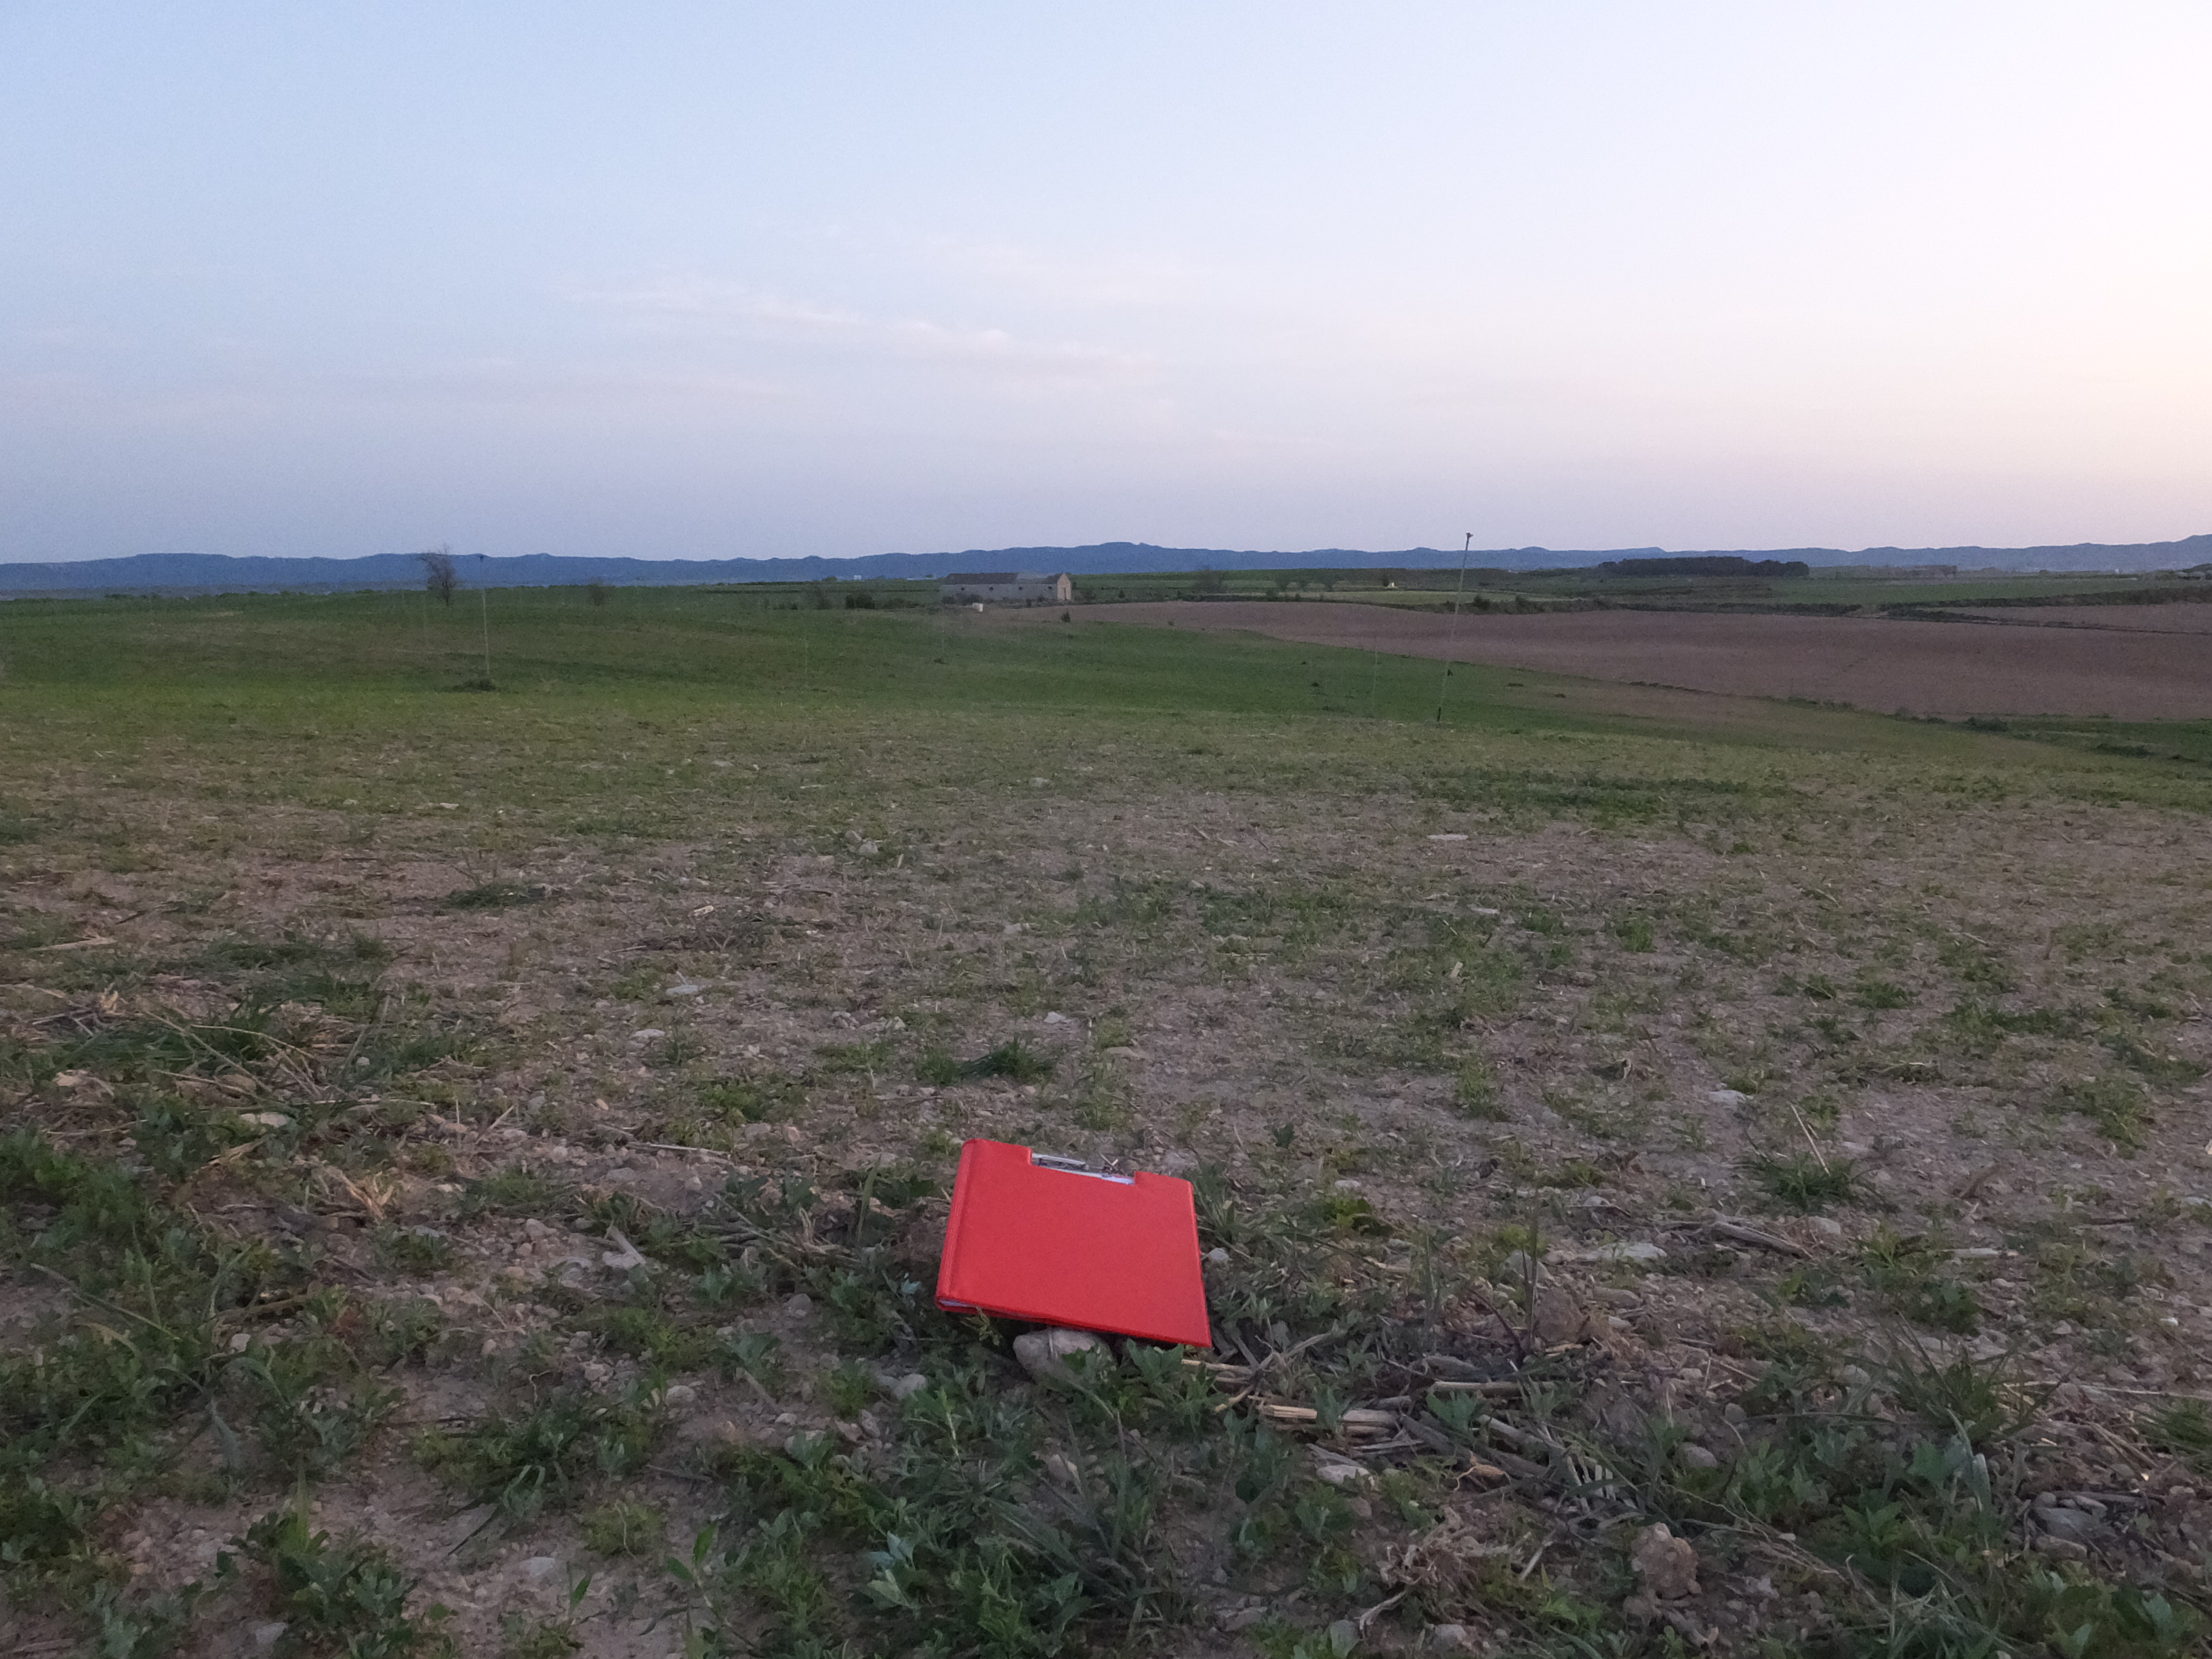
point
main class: Cropland
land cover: Lucerne
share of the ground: > 75 %
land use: Agriculture (excluding fallow land and kitchen gardens)
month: April
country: ES
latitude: 41.8324
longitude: -0.3388
